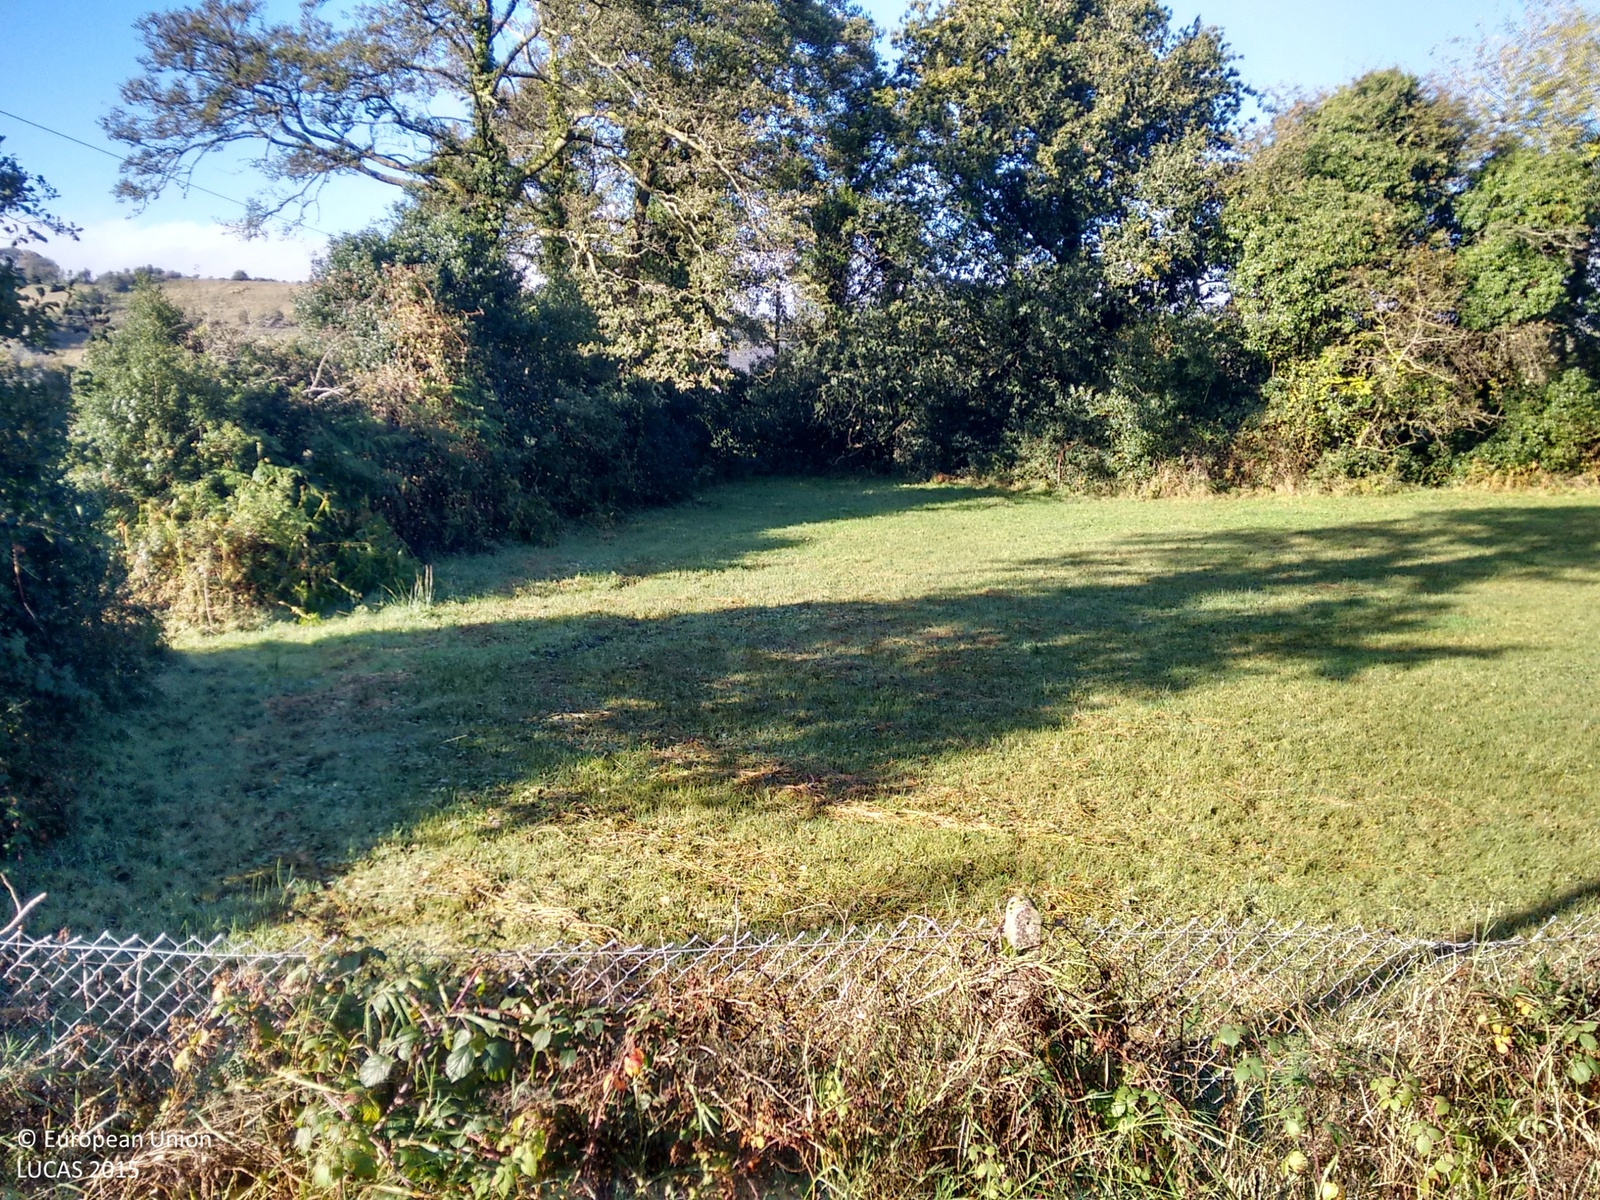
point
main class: Woodland
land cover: Broadleaved woodland
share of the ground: > 75 %
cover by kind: broadleaved forest trees 70 %, shrubs 20 %, herbaceous plants 10 %
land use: Residential
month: October
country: IE
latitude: 54.0917
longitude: -8.0806
